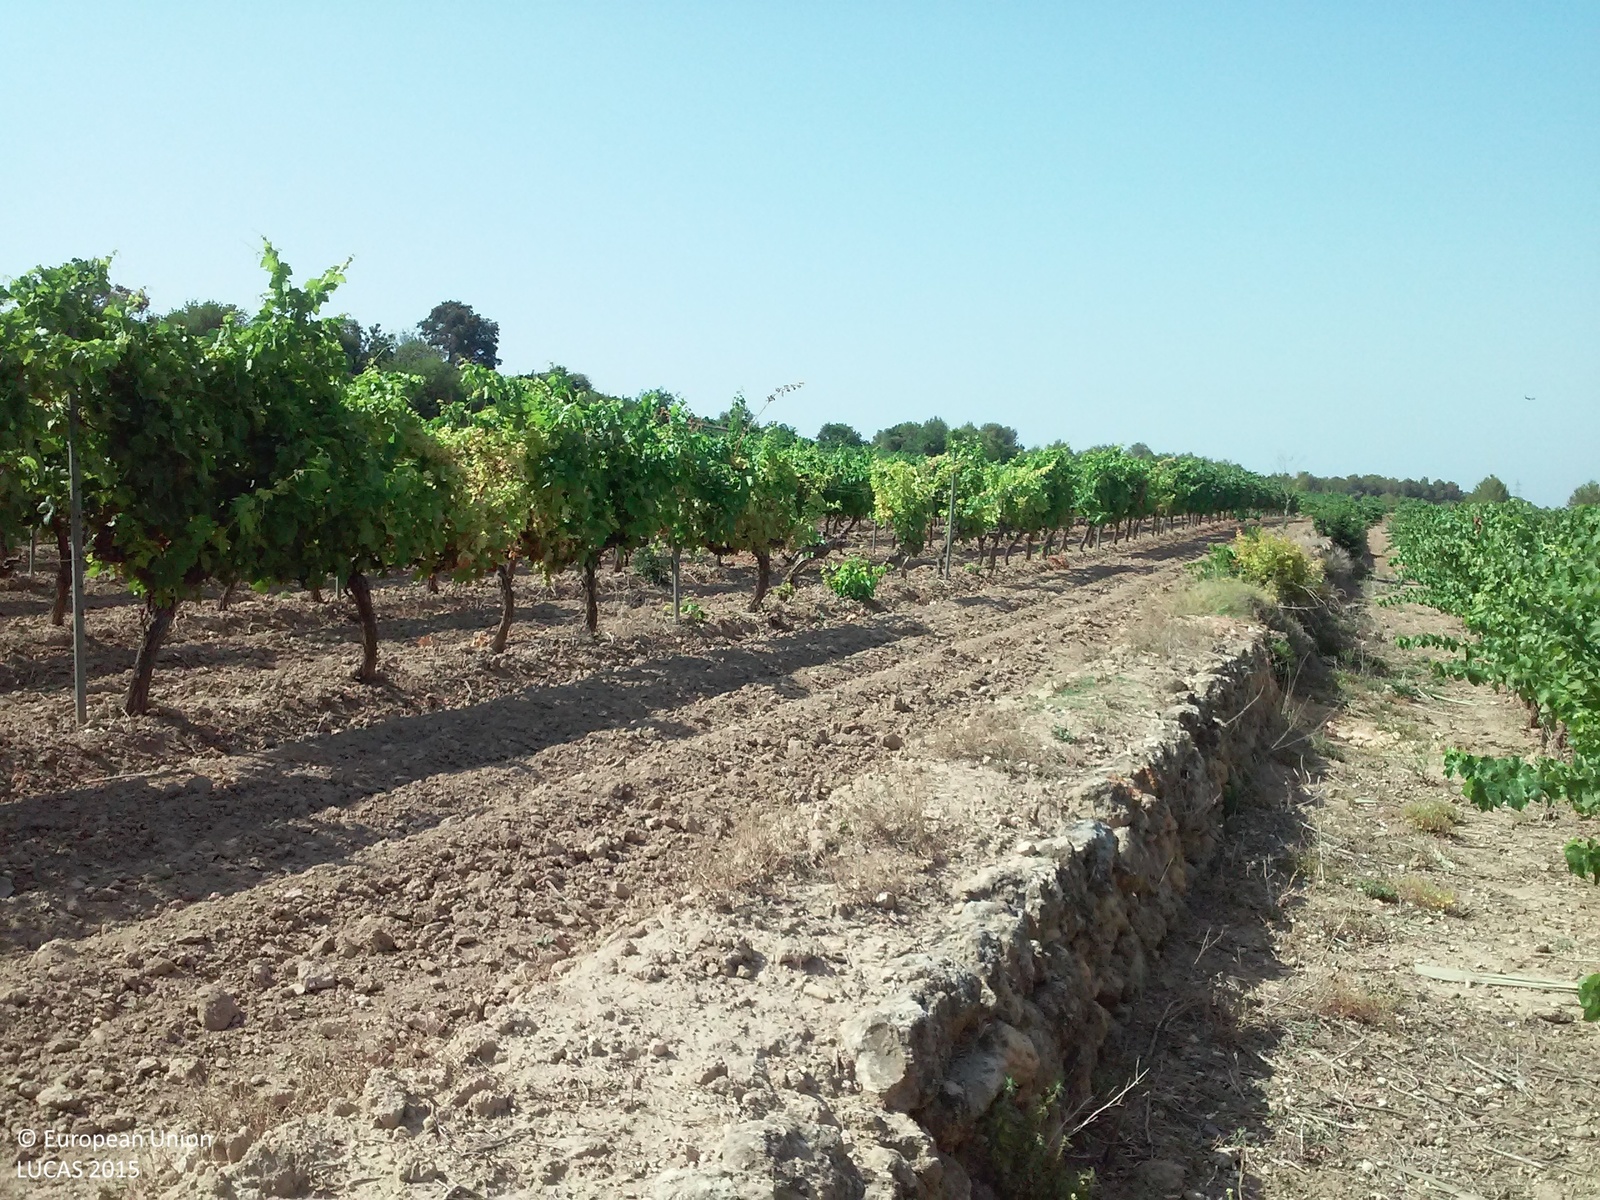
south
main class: Cropland
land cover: Vineyards
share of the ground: 10 - 25 %
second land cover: Other bare soil
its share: > 75 %
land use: Agriculture (excluding fallow land and kitchen gardens)
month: July
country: ES
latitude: 41.2053
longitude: 1.2758
